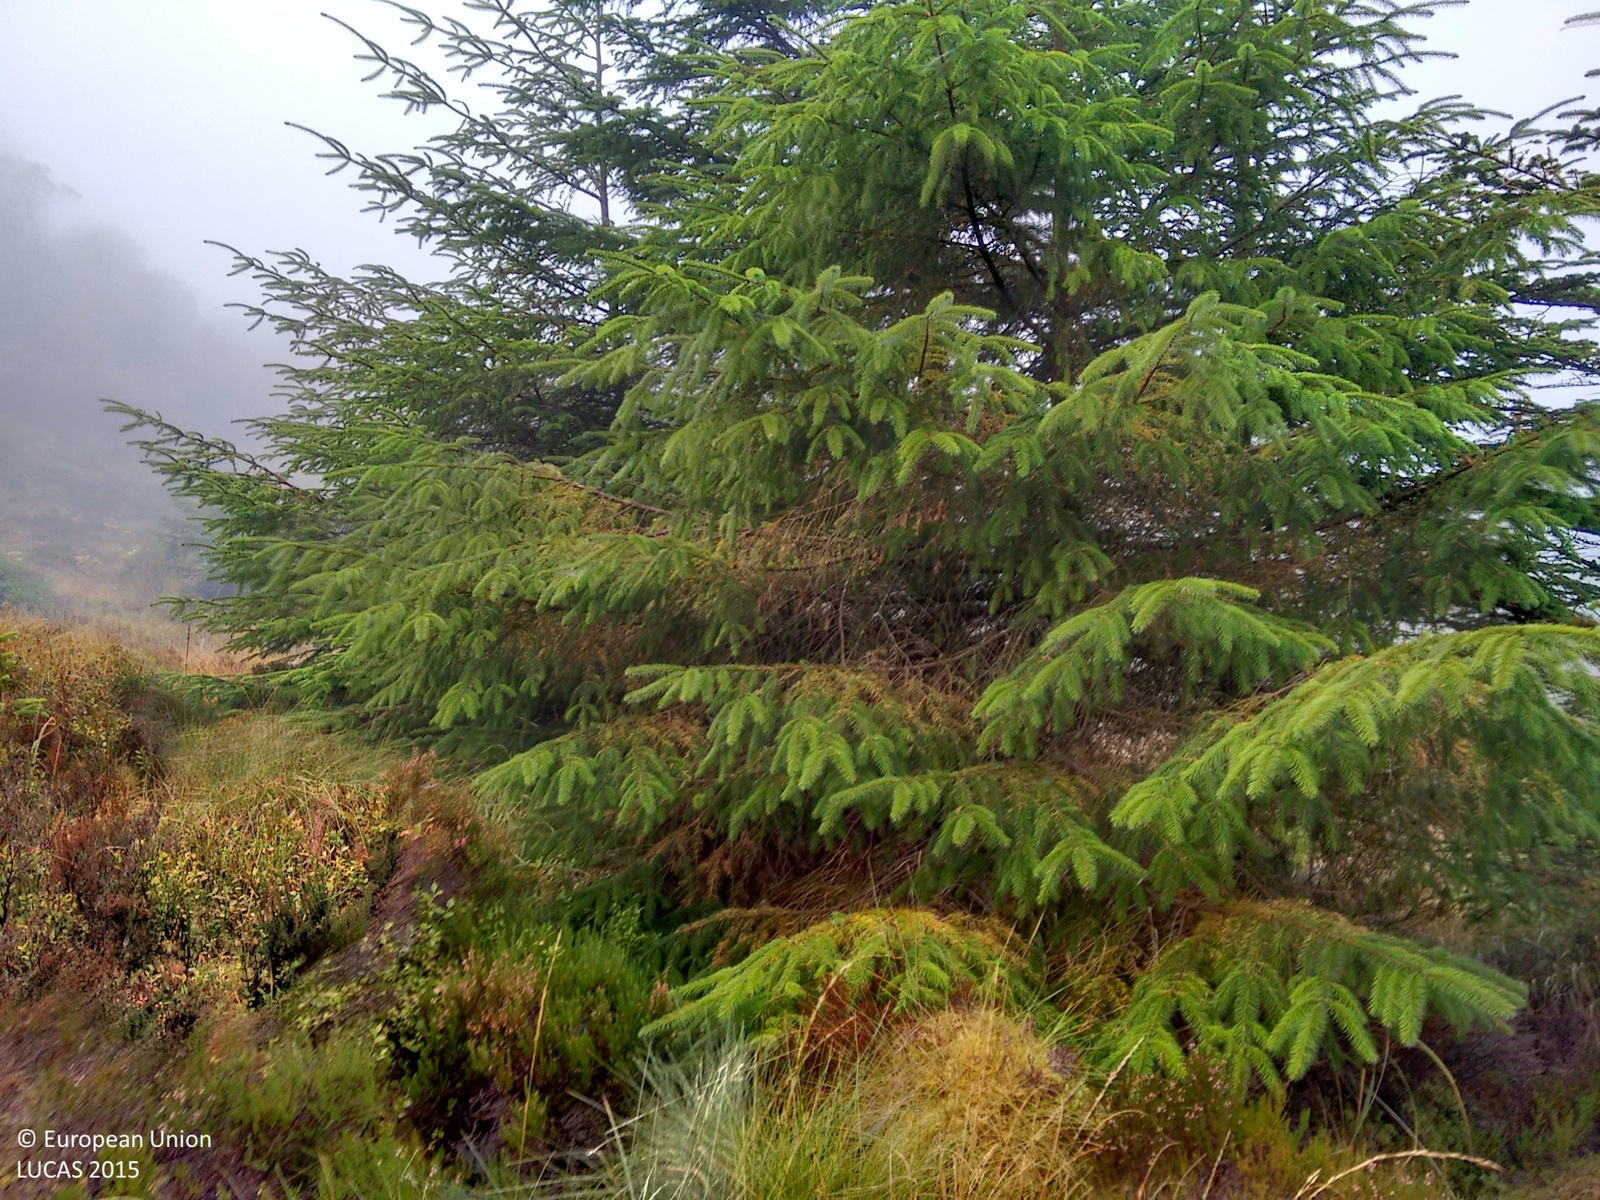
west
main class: Woodland
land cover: Spruce dominated coniferous woodland
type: exotic forest
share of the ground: > 75 %
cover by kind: coniferous forest trees 100 %
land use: Forestry
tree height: > 5 m
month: October
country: GB
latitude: 54.4523
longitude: -7.8908
